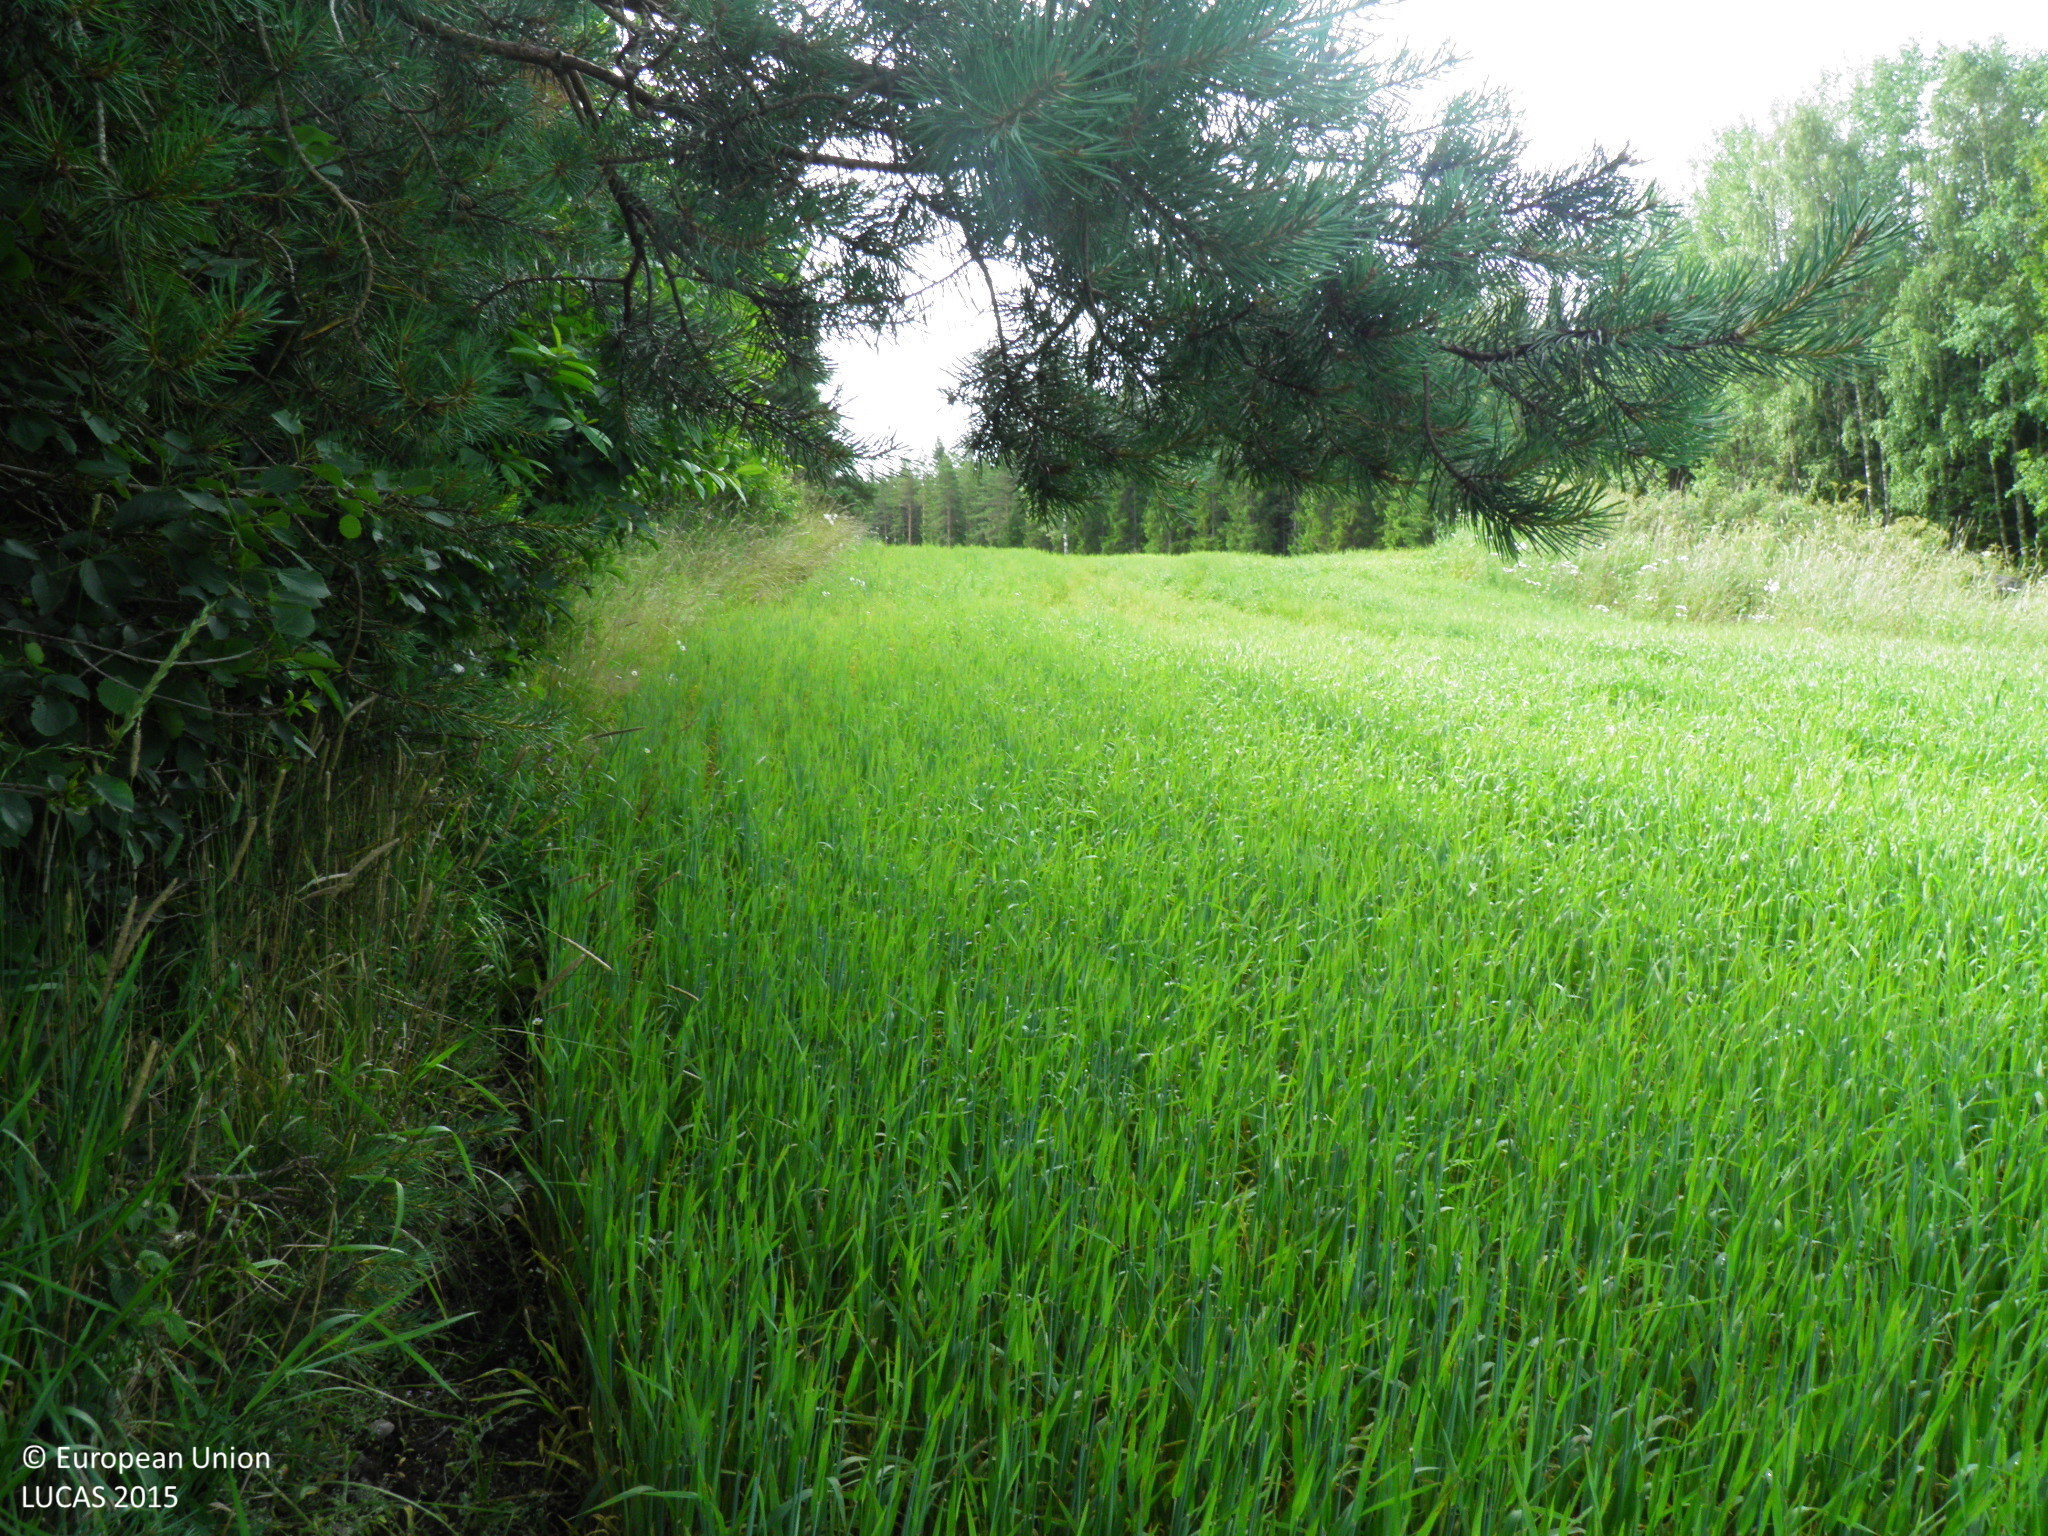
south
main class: Cropland
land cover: Barley
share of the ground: > 75 %
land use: Agriculture (excluding fallow land and kitchen gardens)
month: July
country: FI
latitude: 60.6454
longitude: 21.6334
